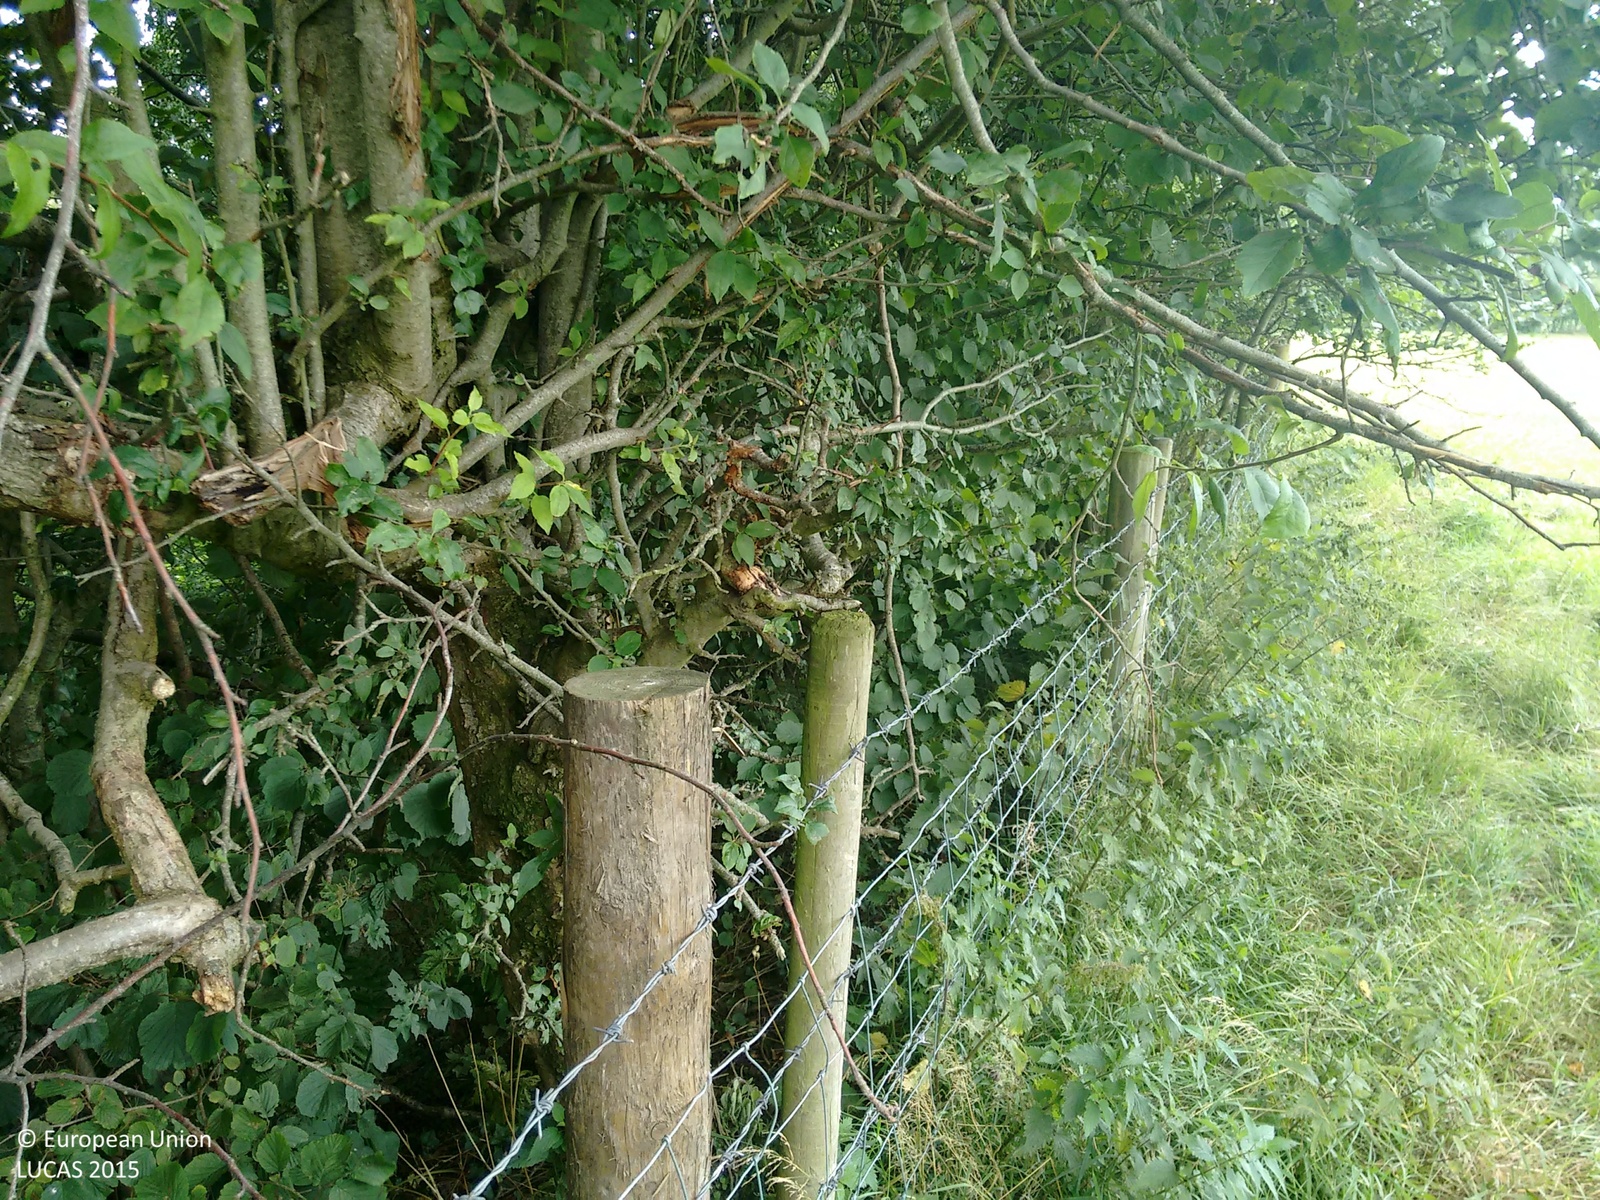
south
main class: Woodland
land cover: Broadleaved woodland
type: mesophytic deciduous forest
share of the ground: > 75 %
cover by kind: broadleaved forest trees 100 %
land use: Abandoned areas
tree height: > 5 m
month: August
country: GB
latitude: 54.3147
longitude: -6.6542
